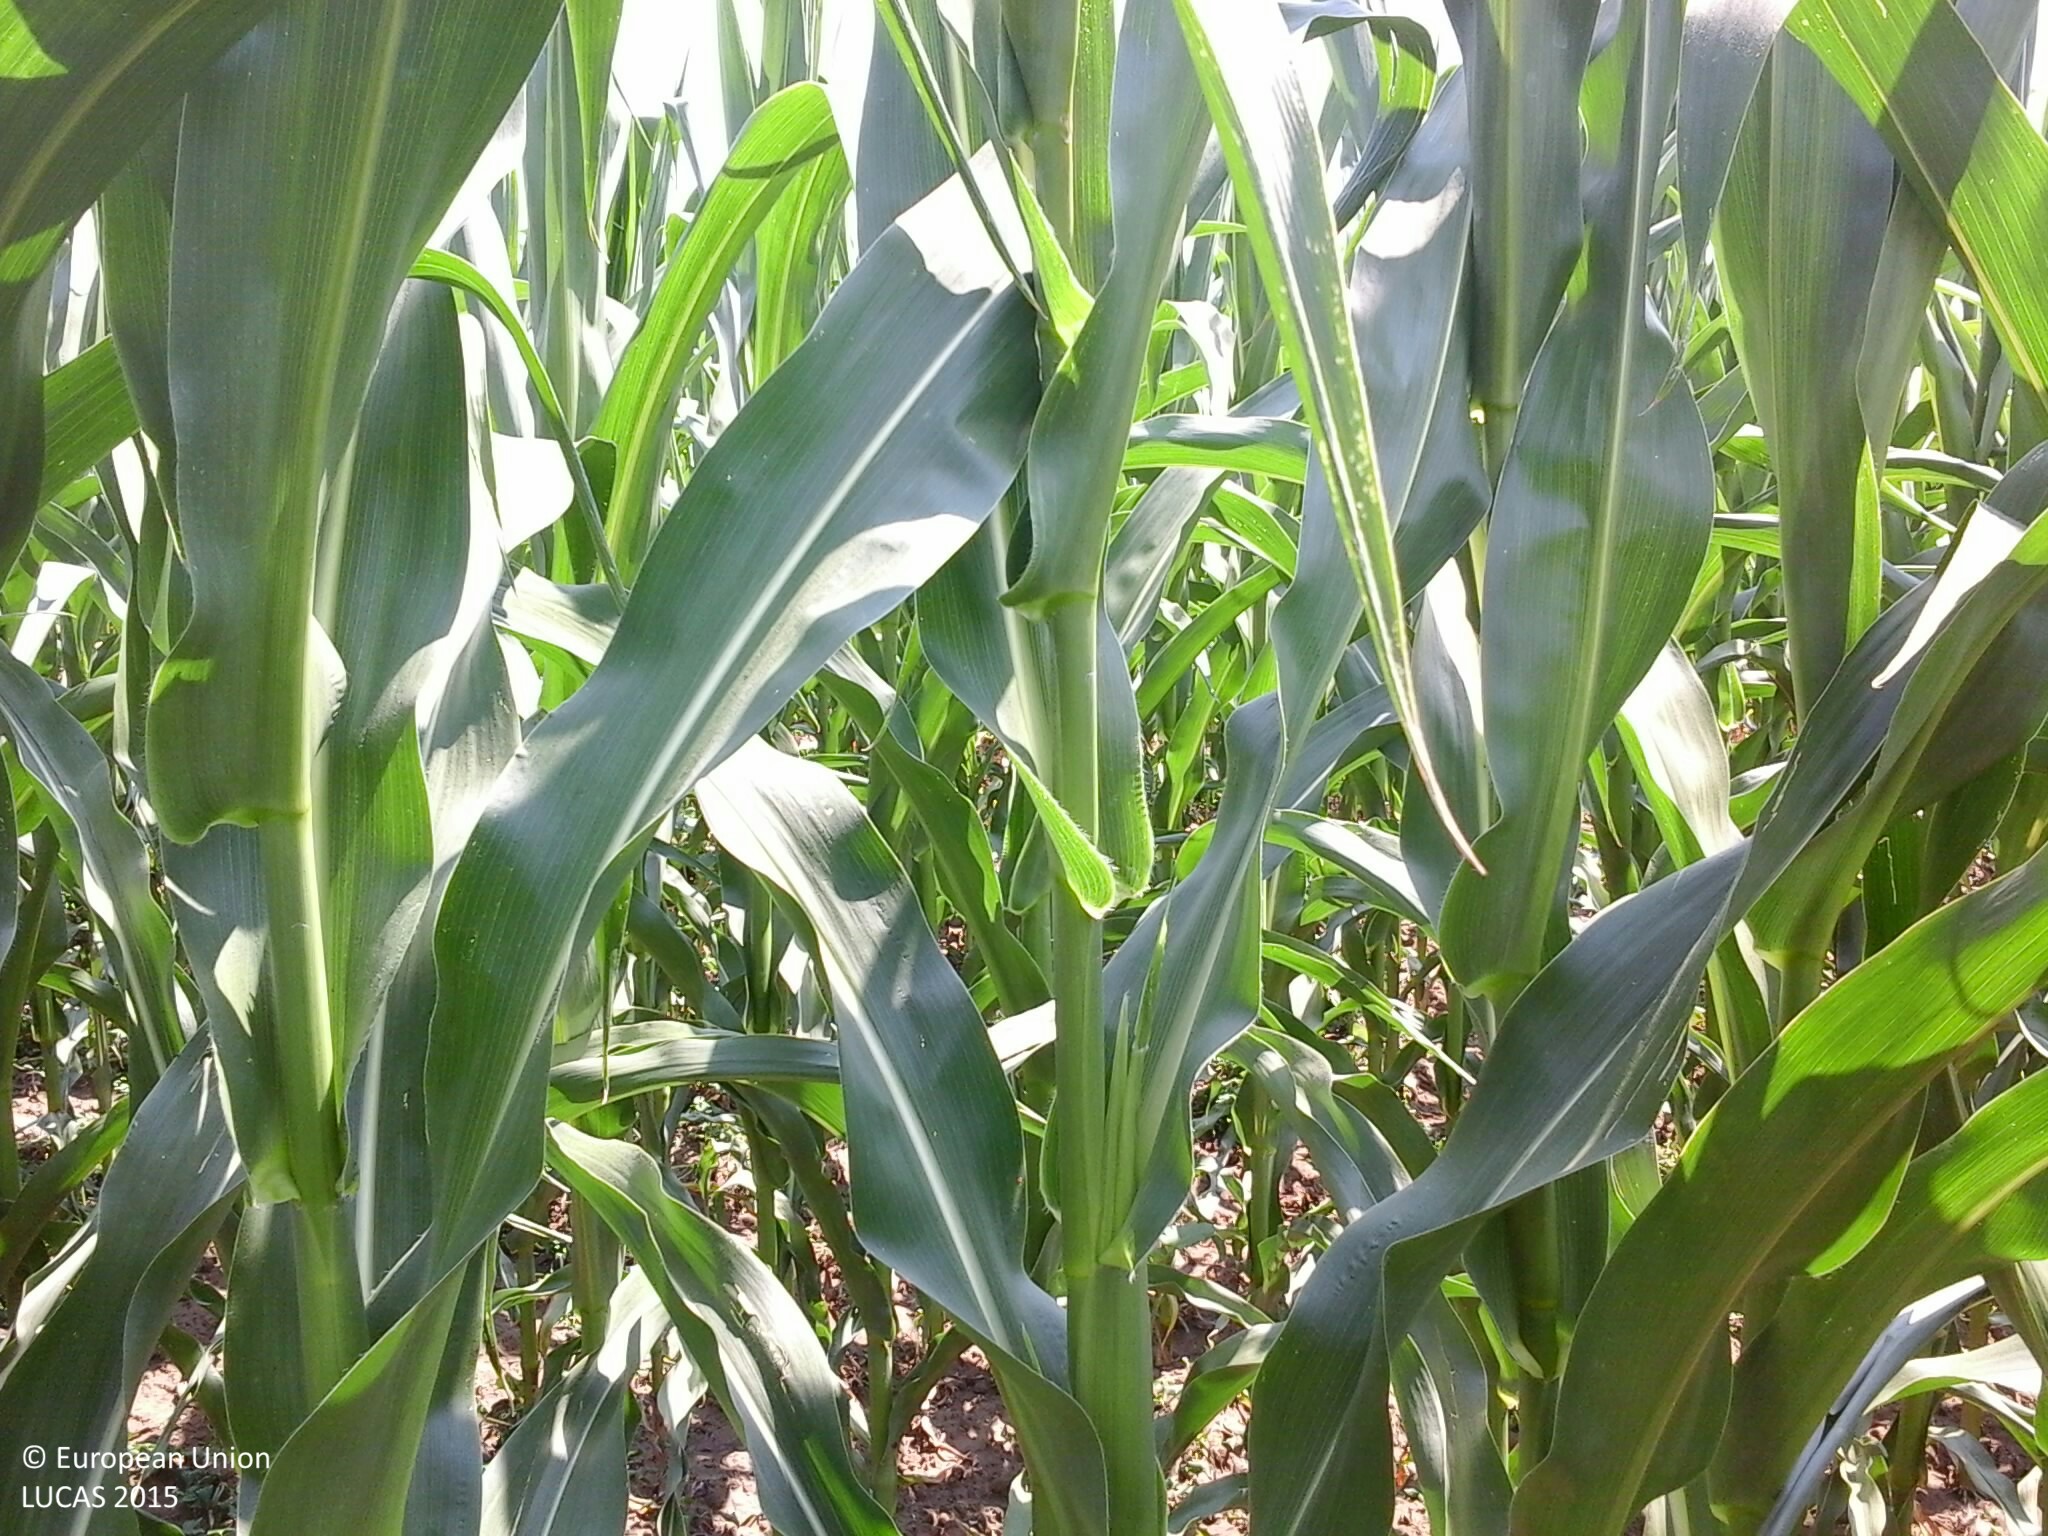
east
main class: Cropland
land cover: Maize
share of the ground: > 75 %
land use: Agriculture (excluding fallow land and kitchen gardens)
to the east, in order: Maize; Triticale; Broadleaved woodland; Grass margins; Tracks; Grass margins; Maize; Triticale
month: July
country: HU
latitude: 47.7929
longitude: 22.0800
